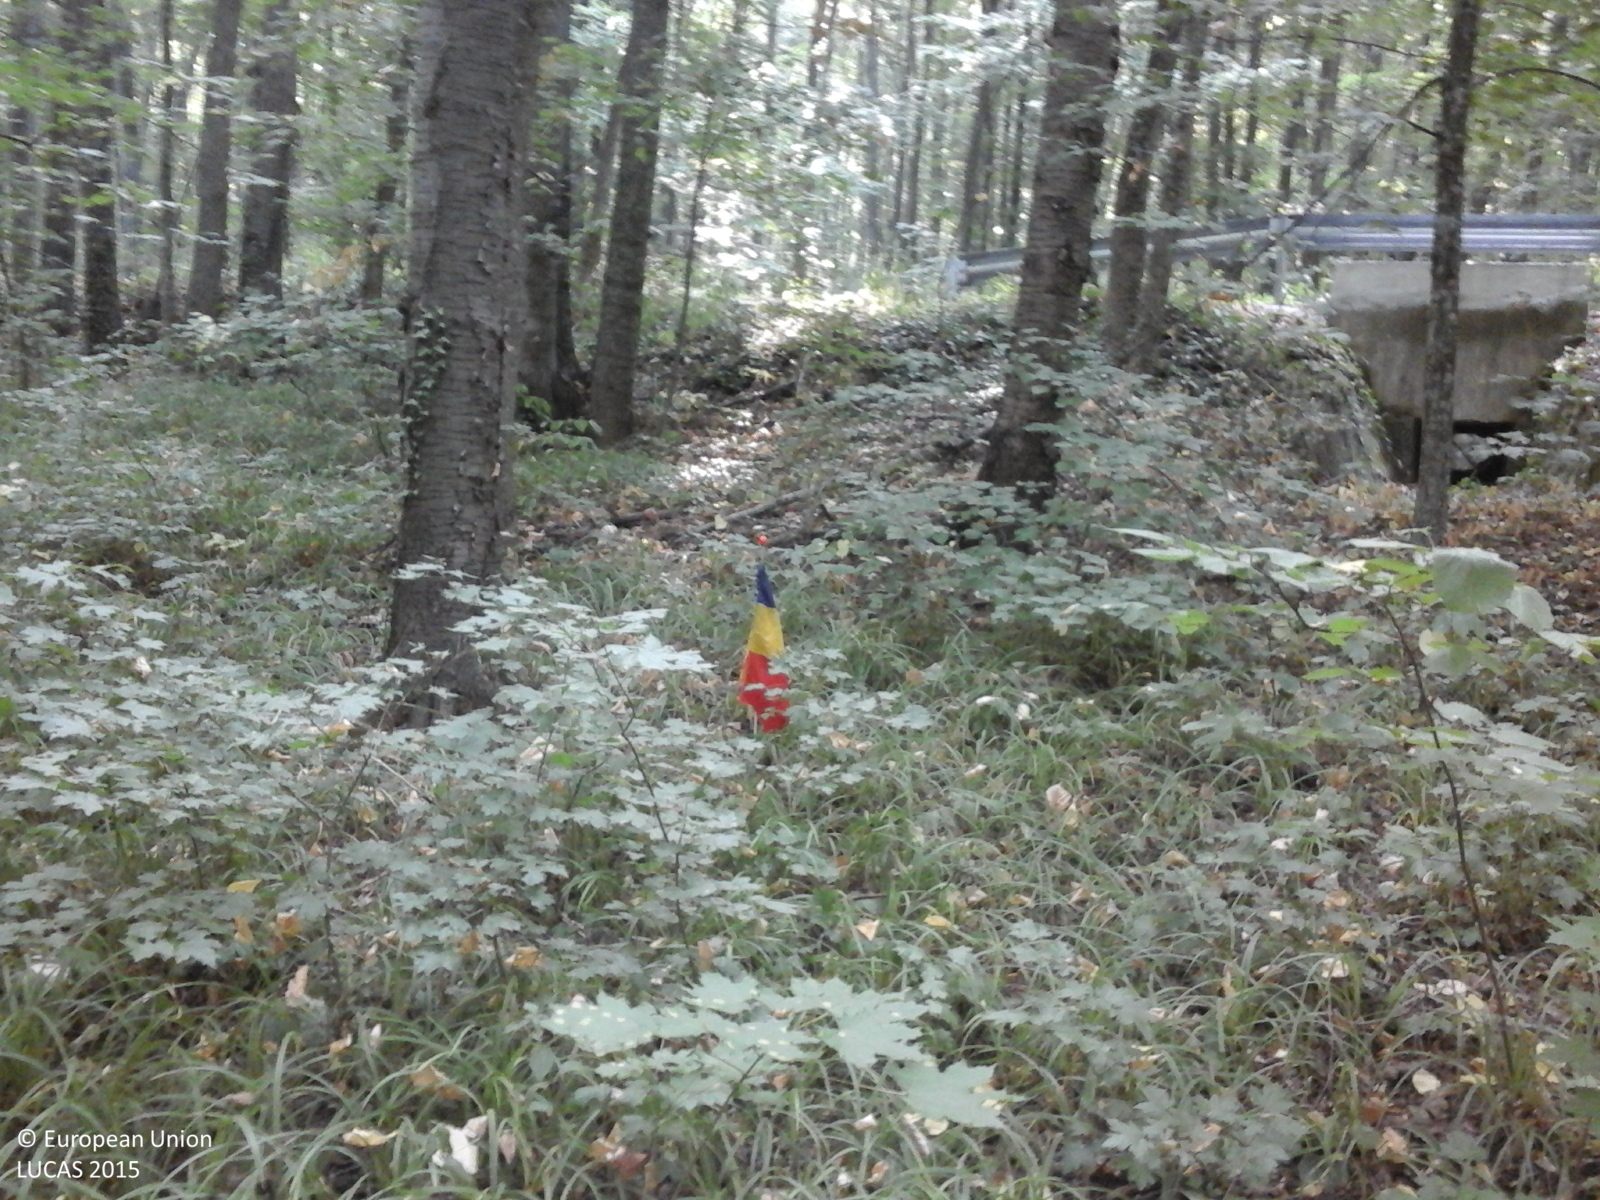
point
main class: Woodland
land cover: Broadleaved woodland
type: mesophytic deciduous forest
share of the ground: > 75 %
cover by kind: broadleaved forest trees 100 %
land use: Forestry
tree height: > 5 m
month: July
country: RO
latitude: 45.2124
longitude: 28.3206
